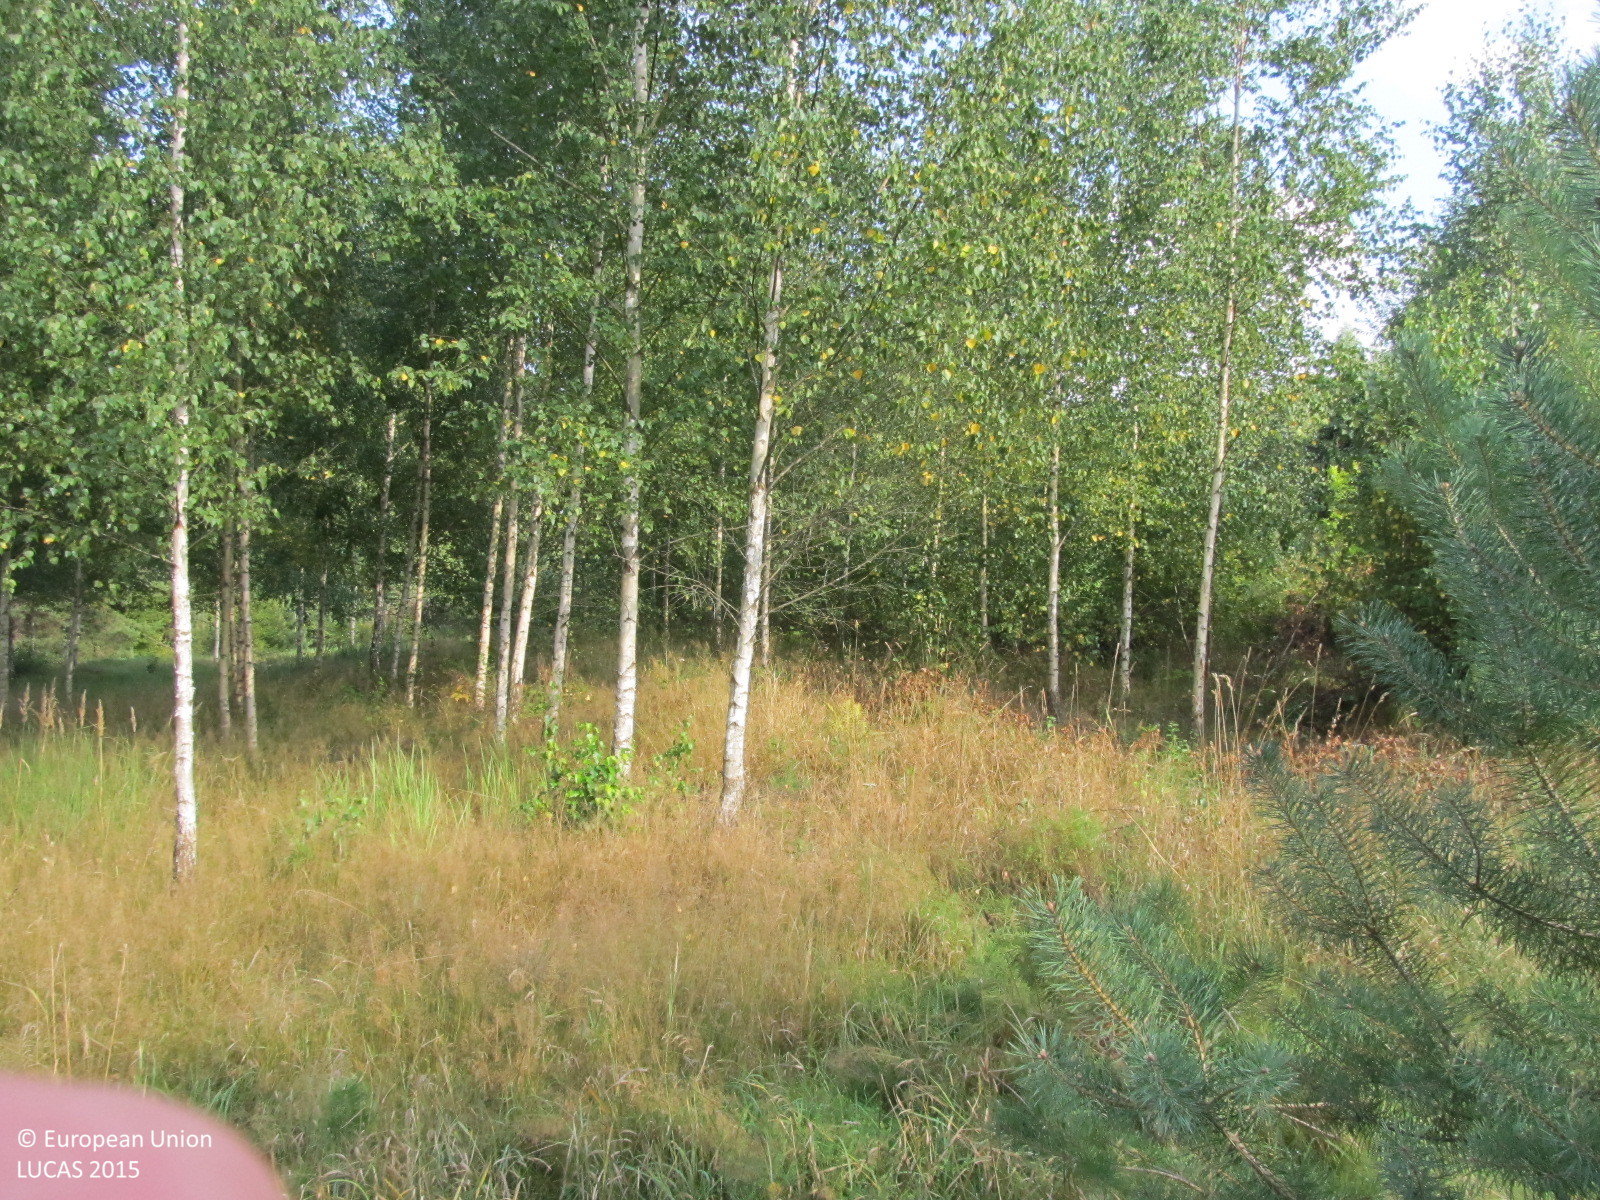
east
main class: Woodland
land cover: Pine dominated coniferous woodland
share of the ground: 25 - 50 %
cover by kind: herbaceous plants 70 %, coniferous forest trees 30 %
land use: Forestry
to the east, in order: Pine dominated coniferous woodland; Broadleaved woodland; Tracks; Grassland without tree/shrub cover; Spruce dominated mixed woodland; Tracks; Grassland with sparse tree/shrub cover
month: August
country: LT
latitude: 55.8214
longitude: 23.1107
